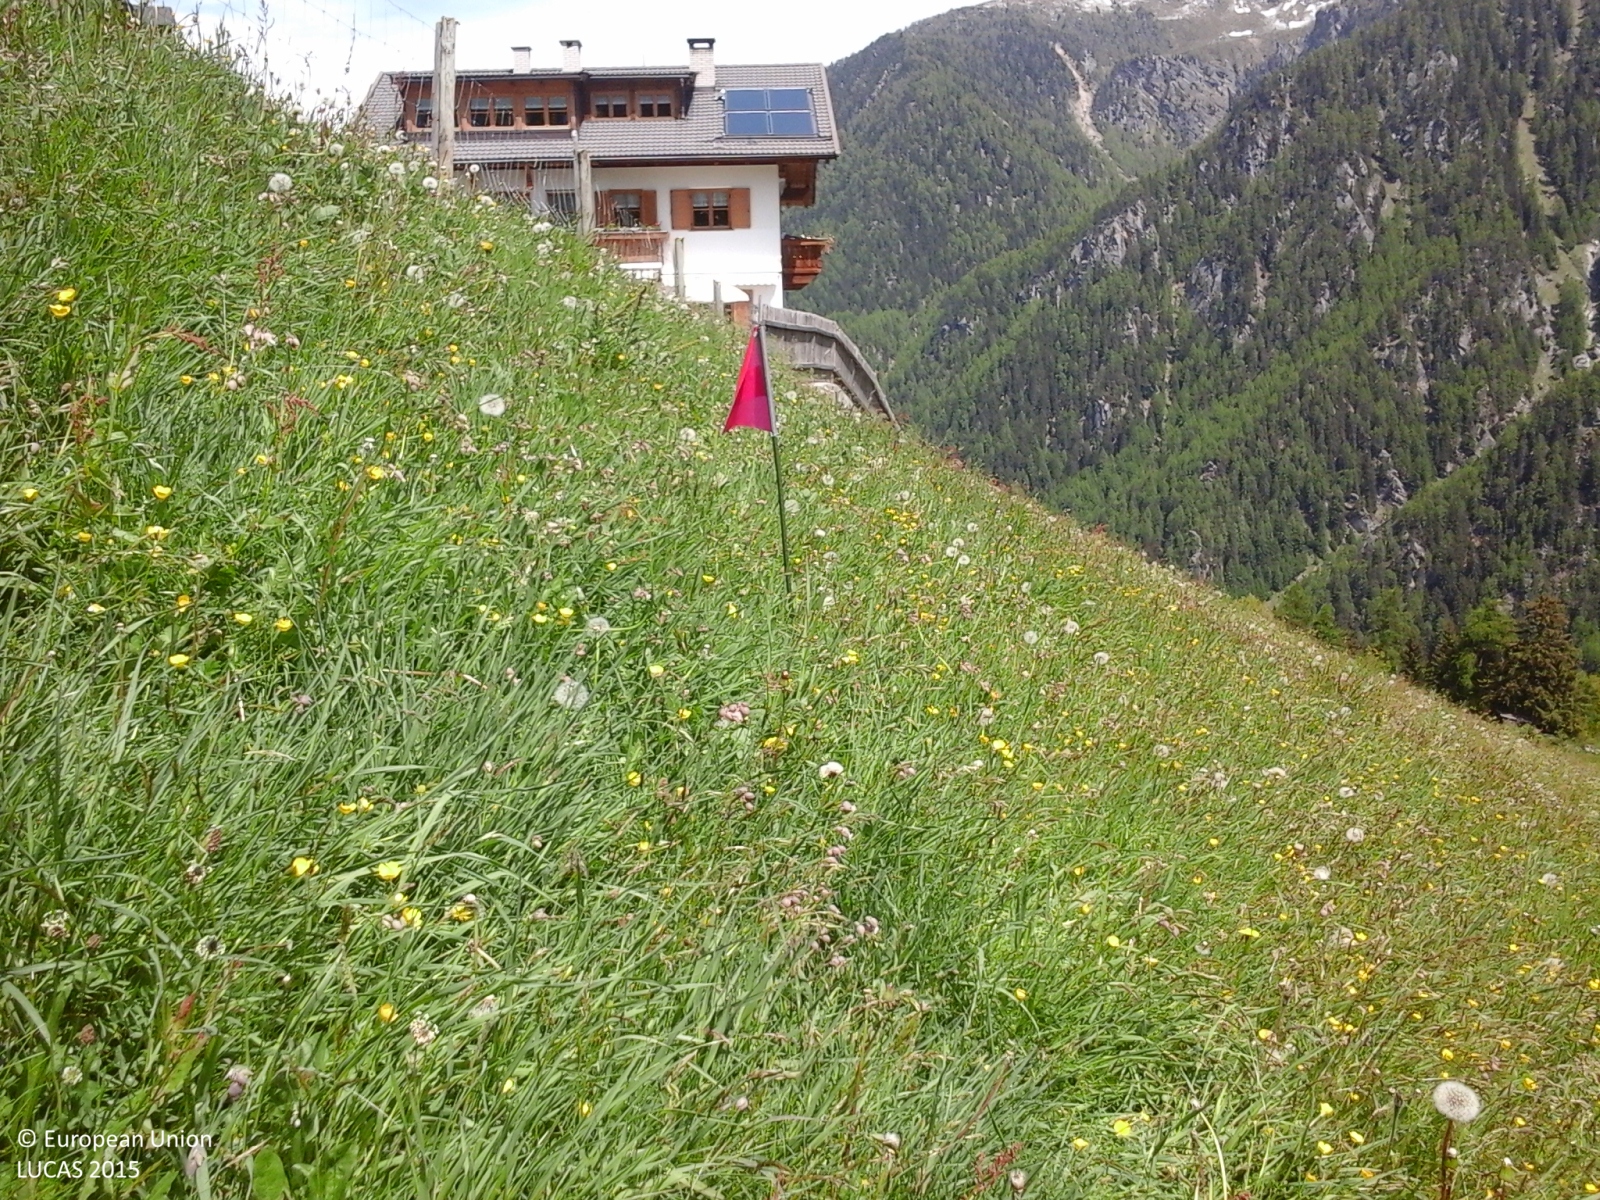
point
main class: Grassland
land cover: Grassland without tree/shrub cover
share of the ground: > 75 %
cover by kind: herbaceous plants 100 %
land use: Agriculture (excluding fallow land and kitchen gardens)
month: May
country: IT
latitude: 46.5466
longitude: 10.7685
